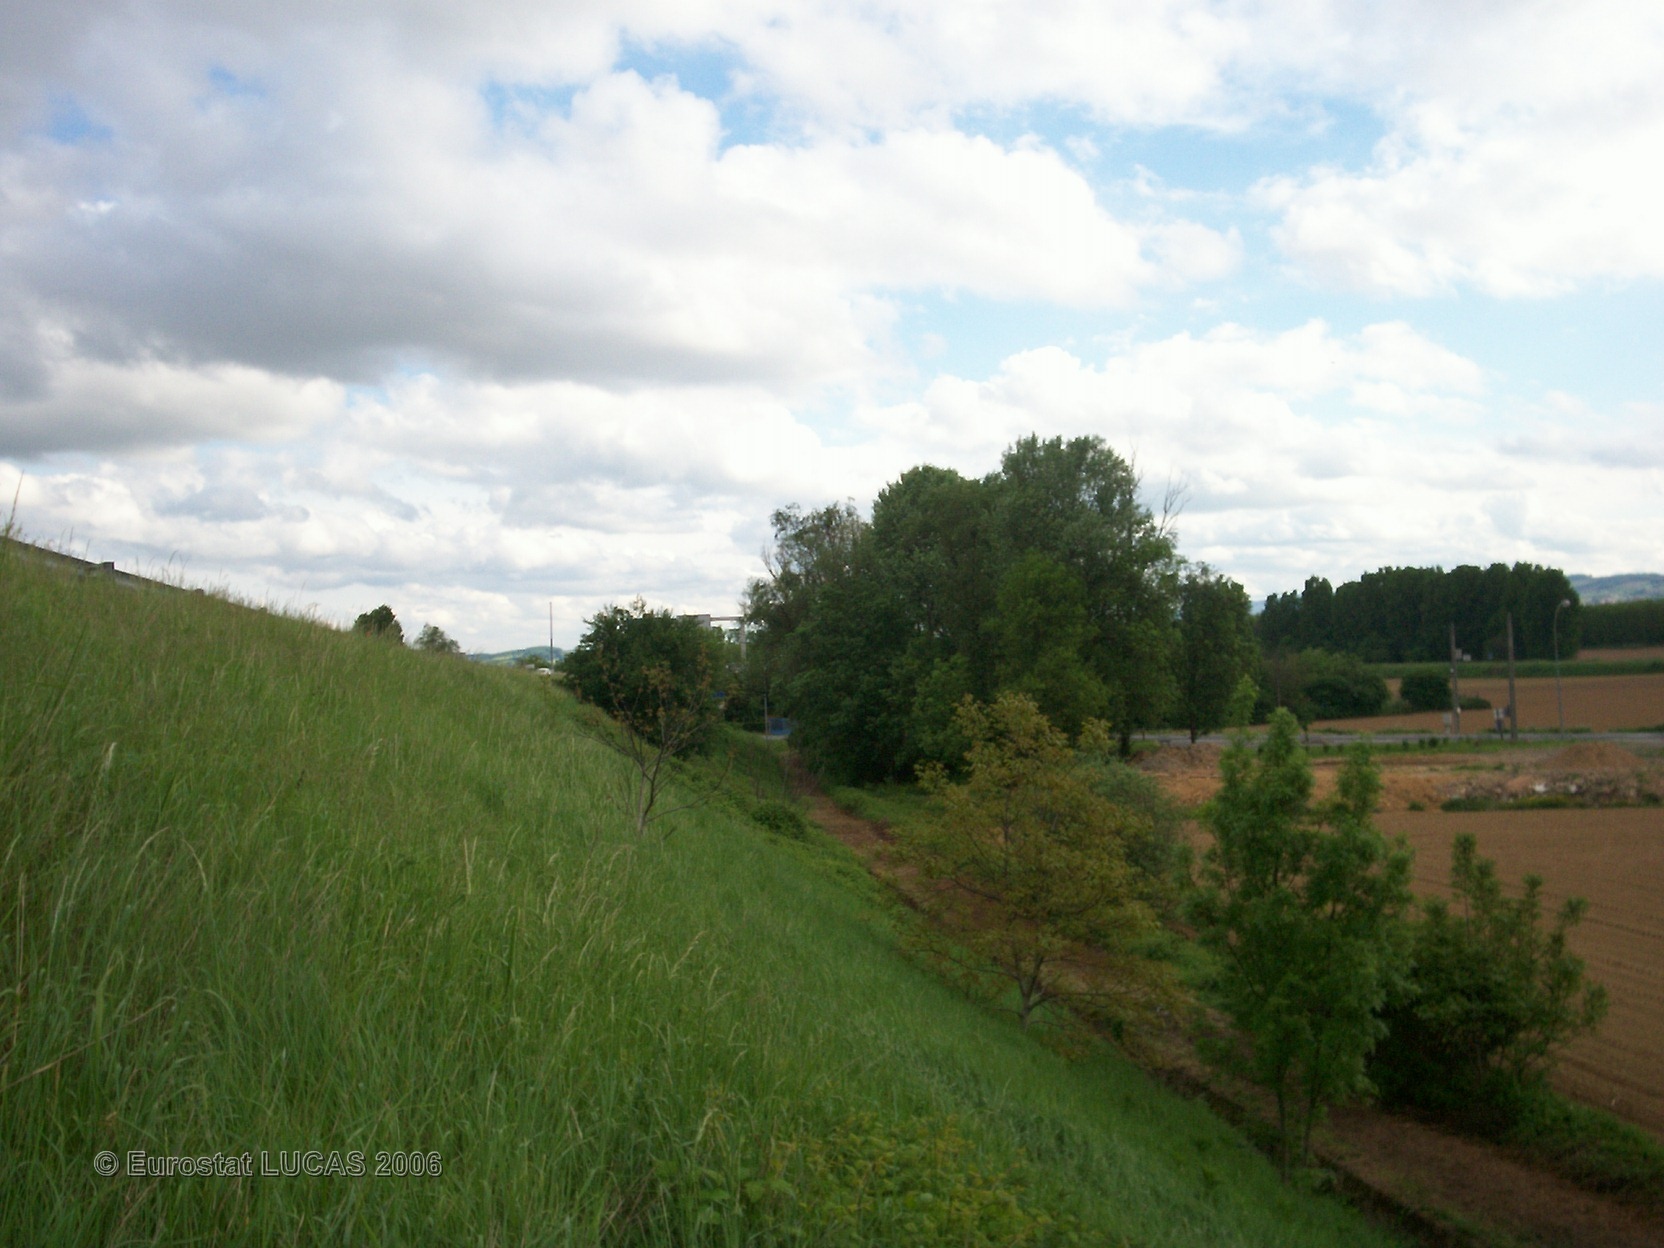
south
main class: Grassland
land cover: Grassland without tree/shrub cover
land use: Unused
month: May
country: FR
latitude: 45.9324
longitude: 4.7282
